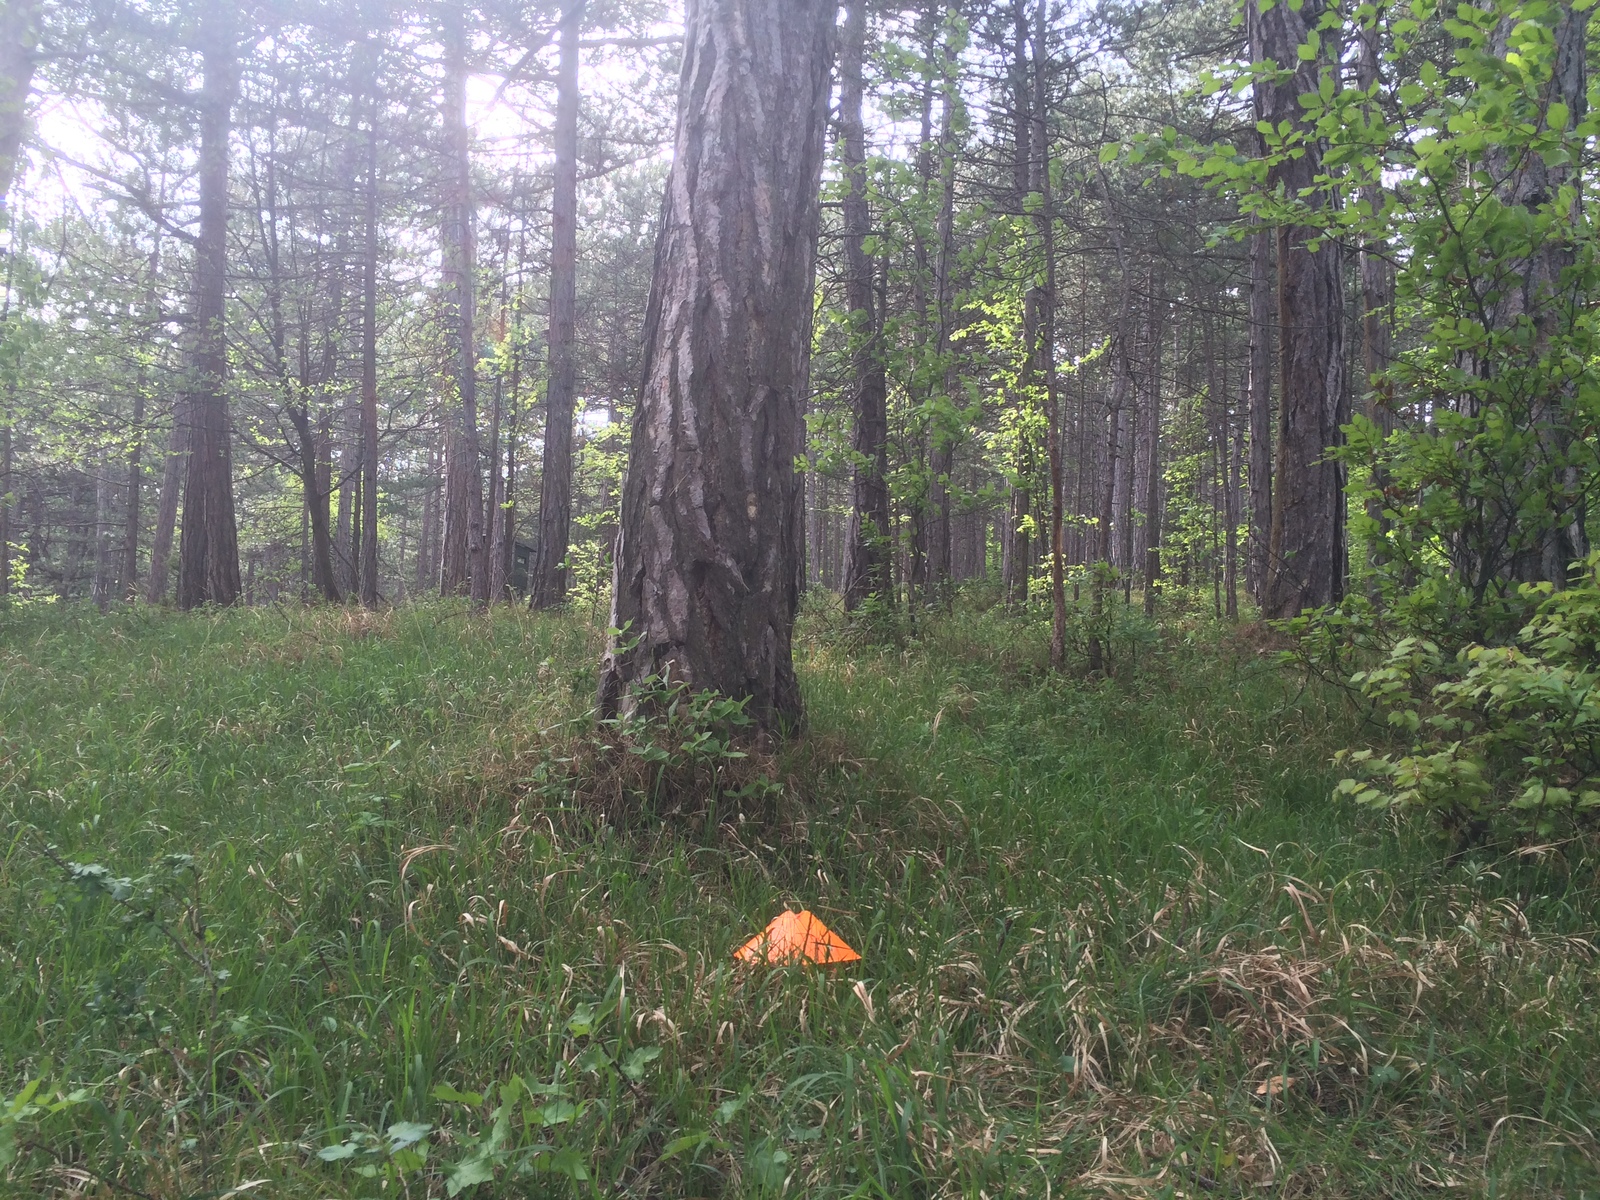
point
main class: Woodland
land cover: Pine dominated coniferous woodland
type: alpine coniferous forest
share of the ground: > 75 %
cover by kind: coniferous forest trees 95 %, broadleaved forest trees 5 %
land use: Forestry
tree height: > 5 m
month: May
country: AT
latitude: 47.9108
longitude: 16.0911
